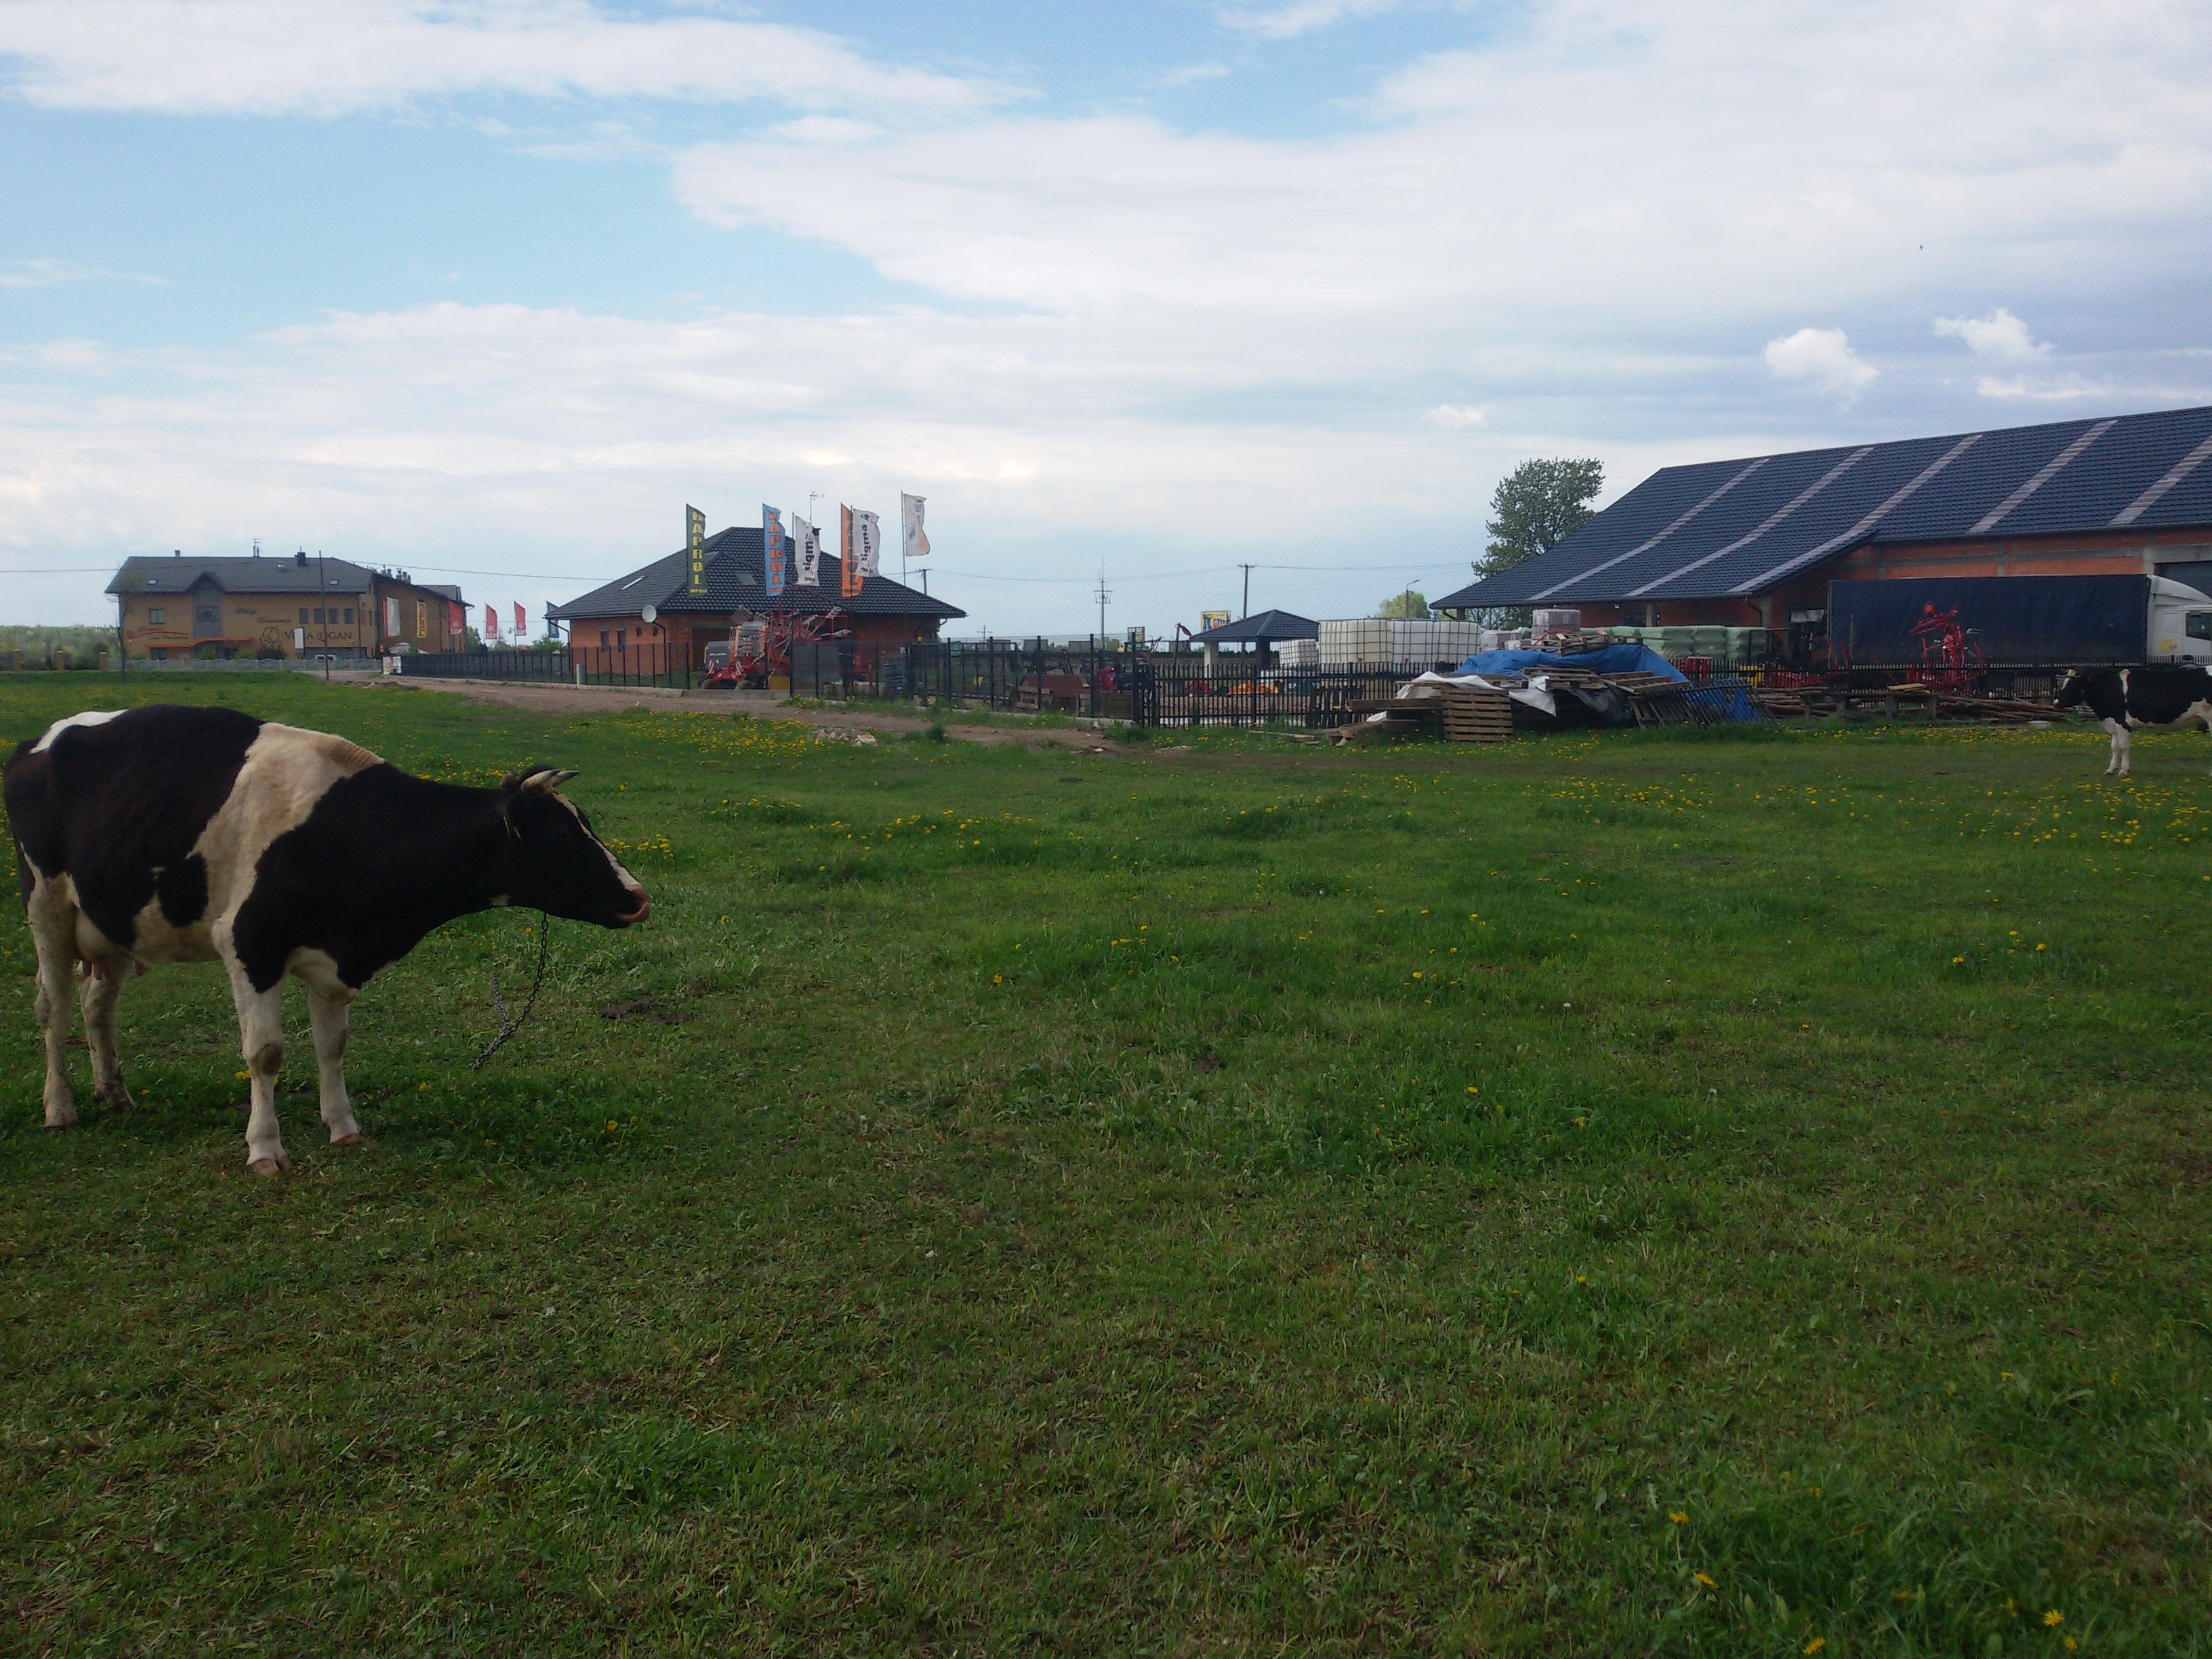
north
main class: Grassland
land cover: Grassland without tree/shrub cover
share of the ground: > 75 %
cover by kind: herbaceous plants 100 %
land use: Agriculture (excluding fallow land and kitchen gardens)
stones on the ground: < 10 %
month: May
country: PL
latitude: 52.9940
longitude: 22.2640
